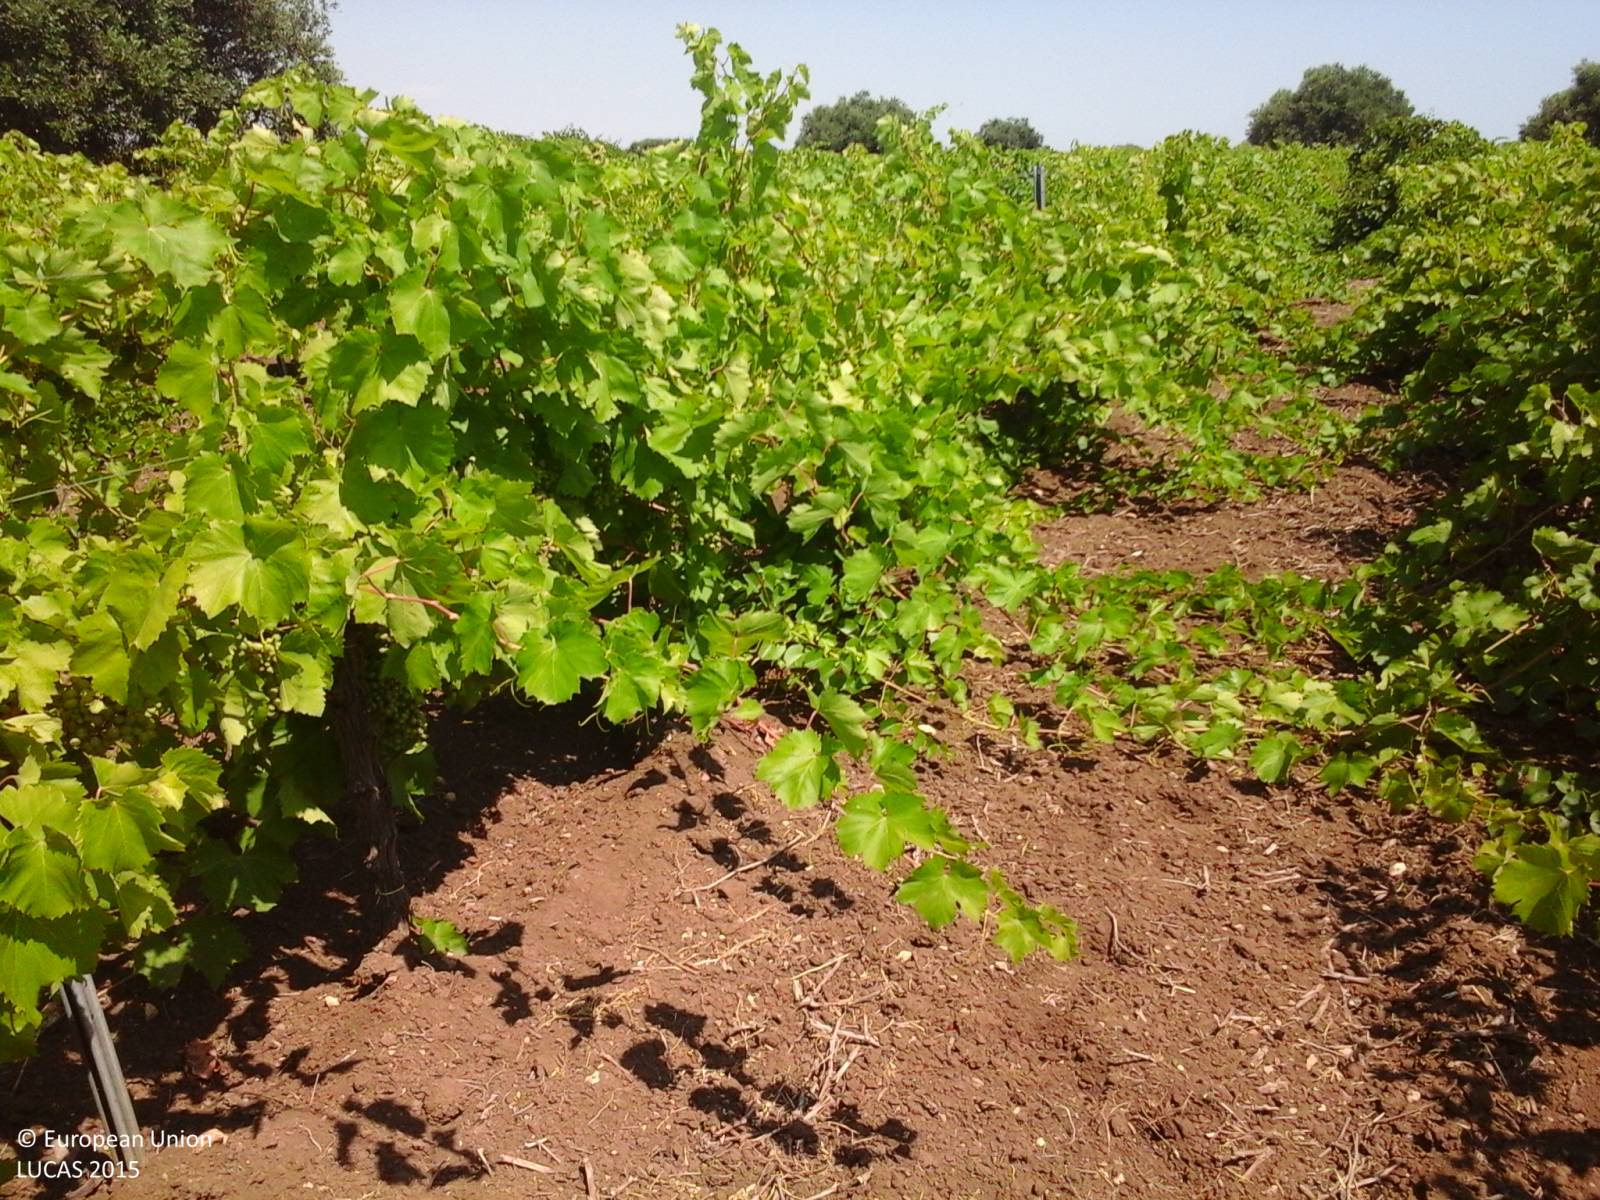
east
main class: Cropland
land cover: Vineyards
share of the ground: 50 - 75 %
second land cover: Other bare soil
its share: > 75 %
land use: Agriculture (excluding fallow land and kitchen gardens)
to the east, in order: Vineyards; Other bare soil; Olive groves; Vineyards; Spontaneously vegetated surfaces; Vineyards; Tracks; Olive groves; Vineyards
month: July
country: IT
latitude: 37.7289
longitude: 12.6464
